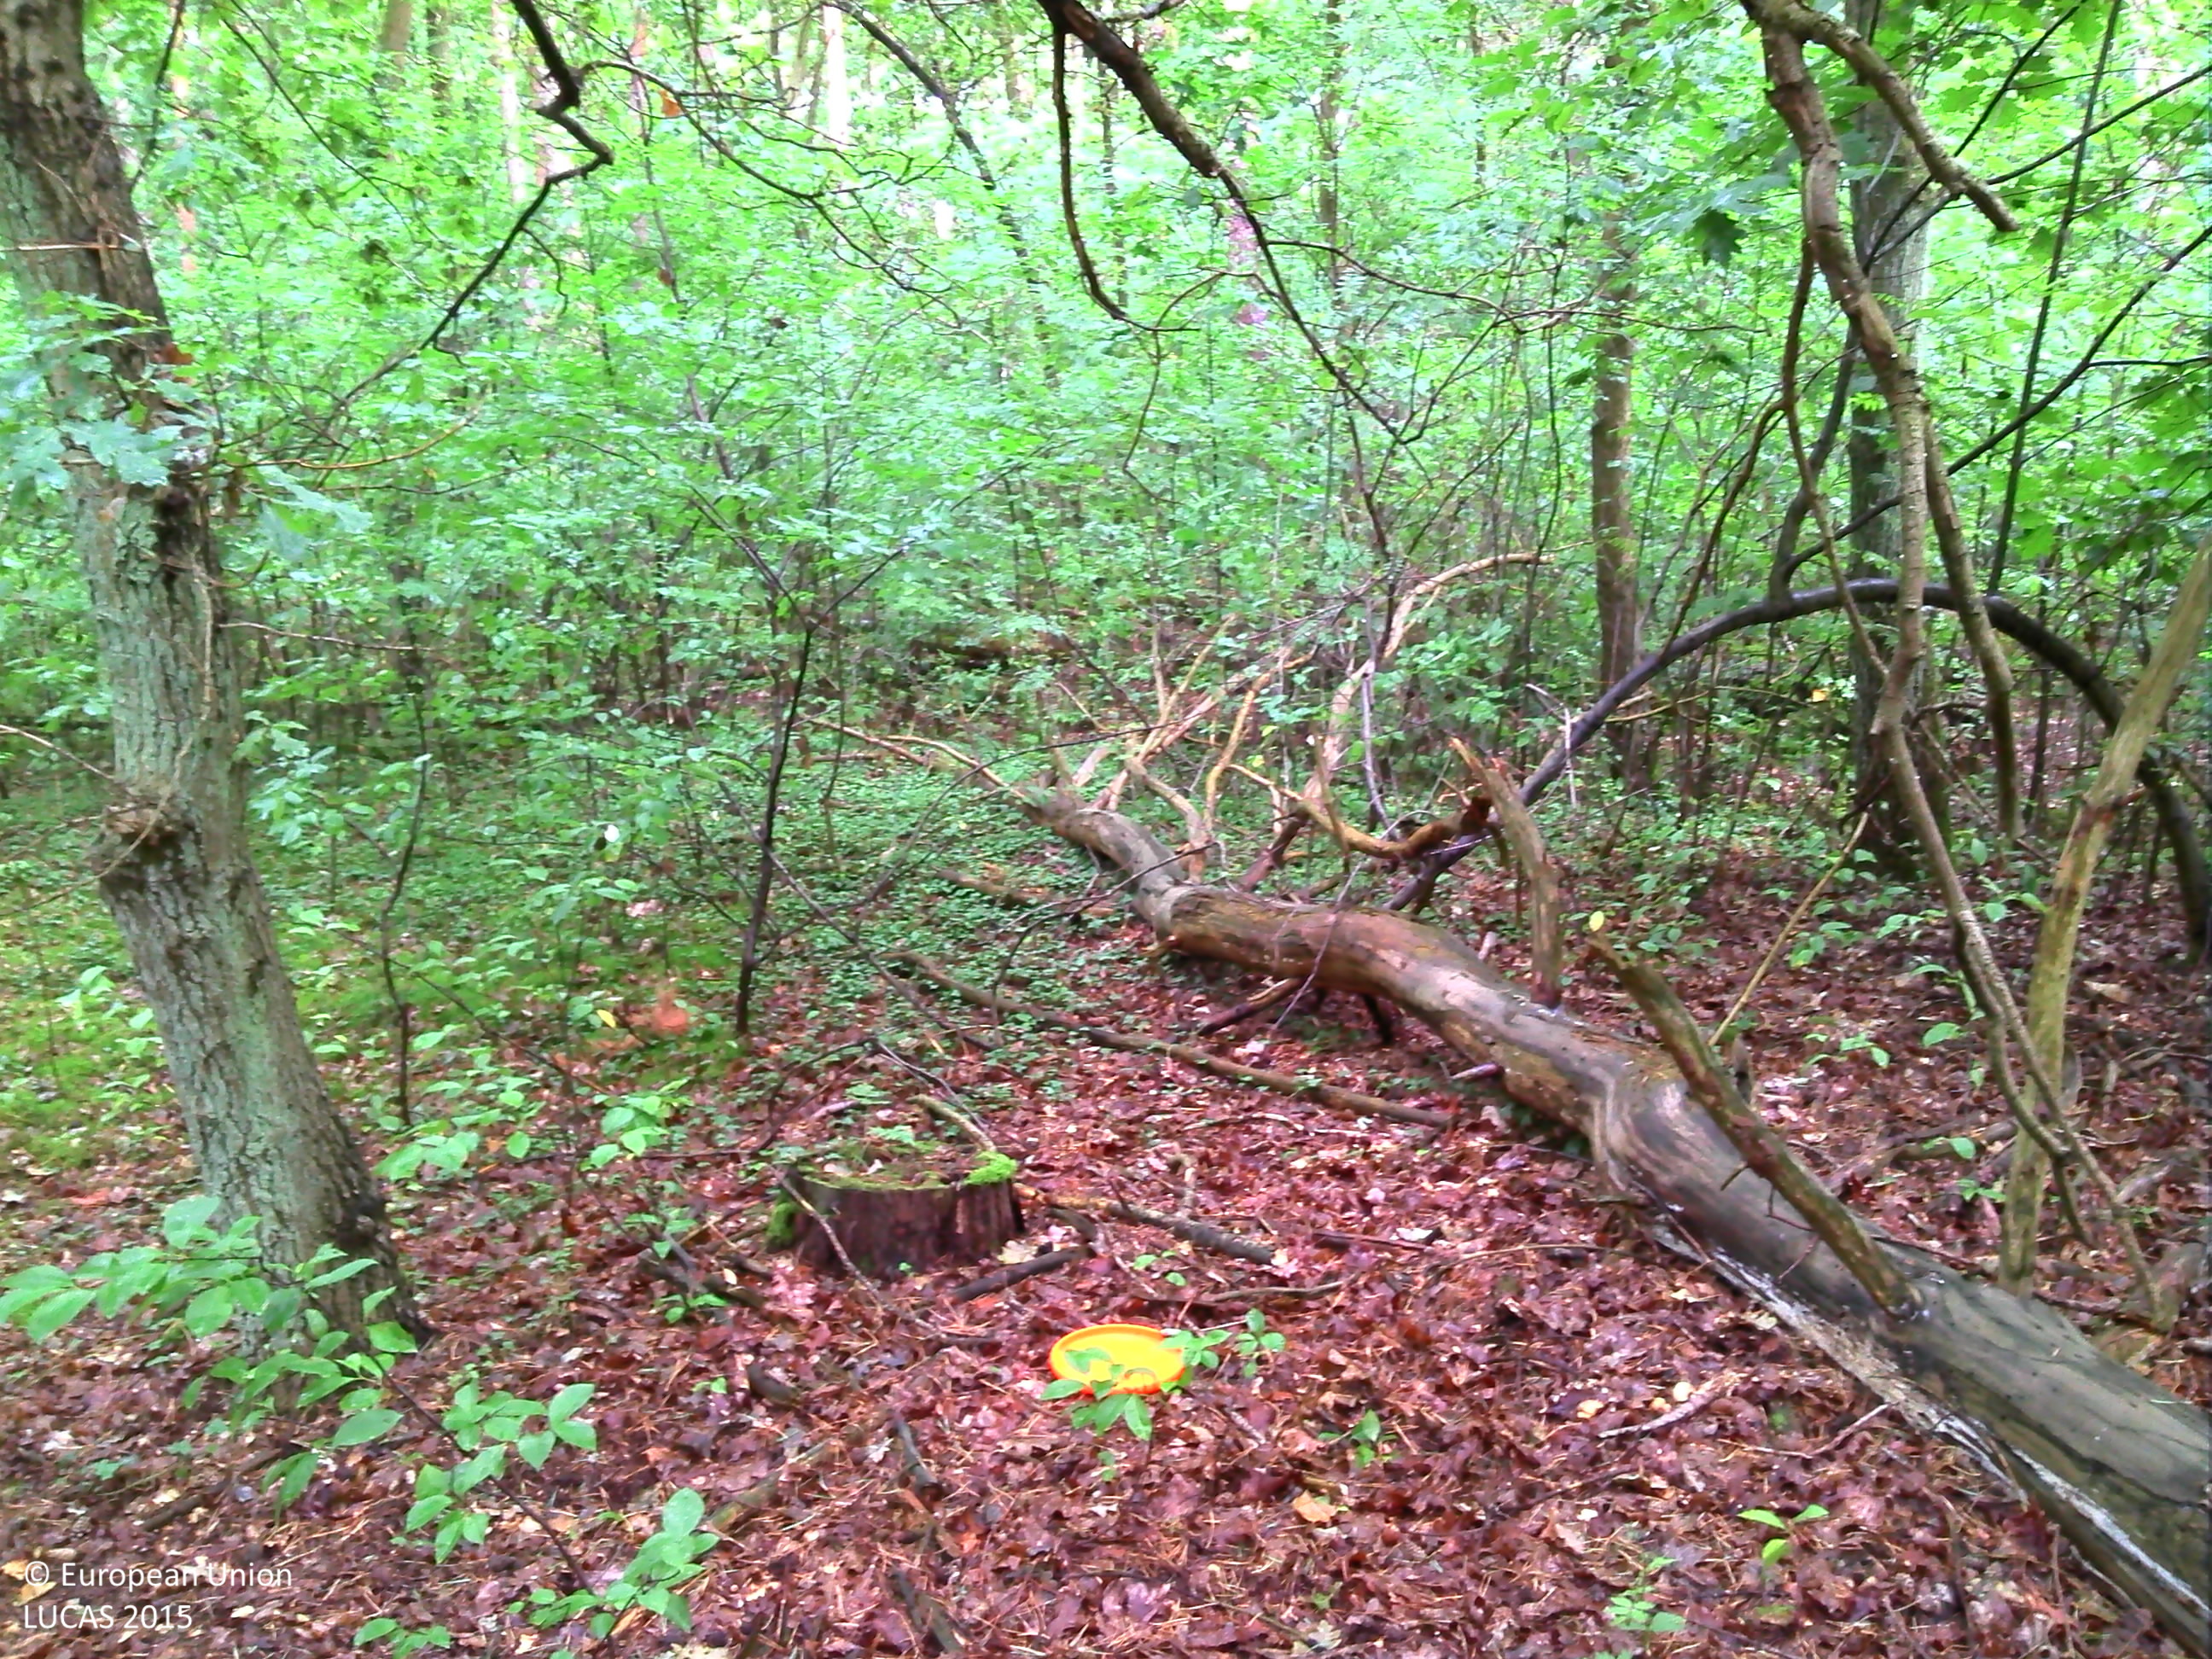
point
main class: Woodland
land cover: Pine dominated mixed woodland
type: hemiboreal forest and nemoral coniferous forest and mixed broadleaved-coniferous forest
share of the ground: > 75 %
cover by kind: coniferous forest trees 60 %, broadleaved forest trees 40 %
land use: Forestry
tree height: > 5 m
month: August
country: BE
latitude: 50.9425
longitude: 5.5151
